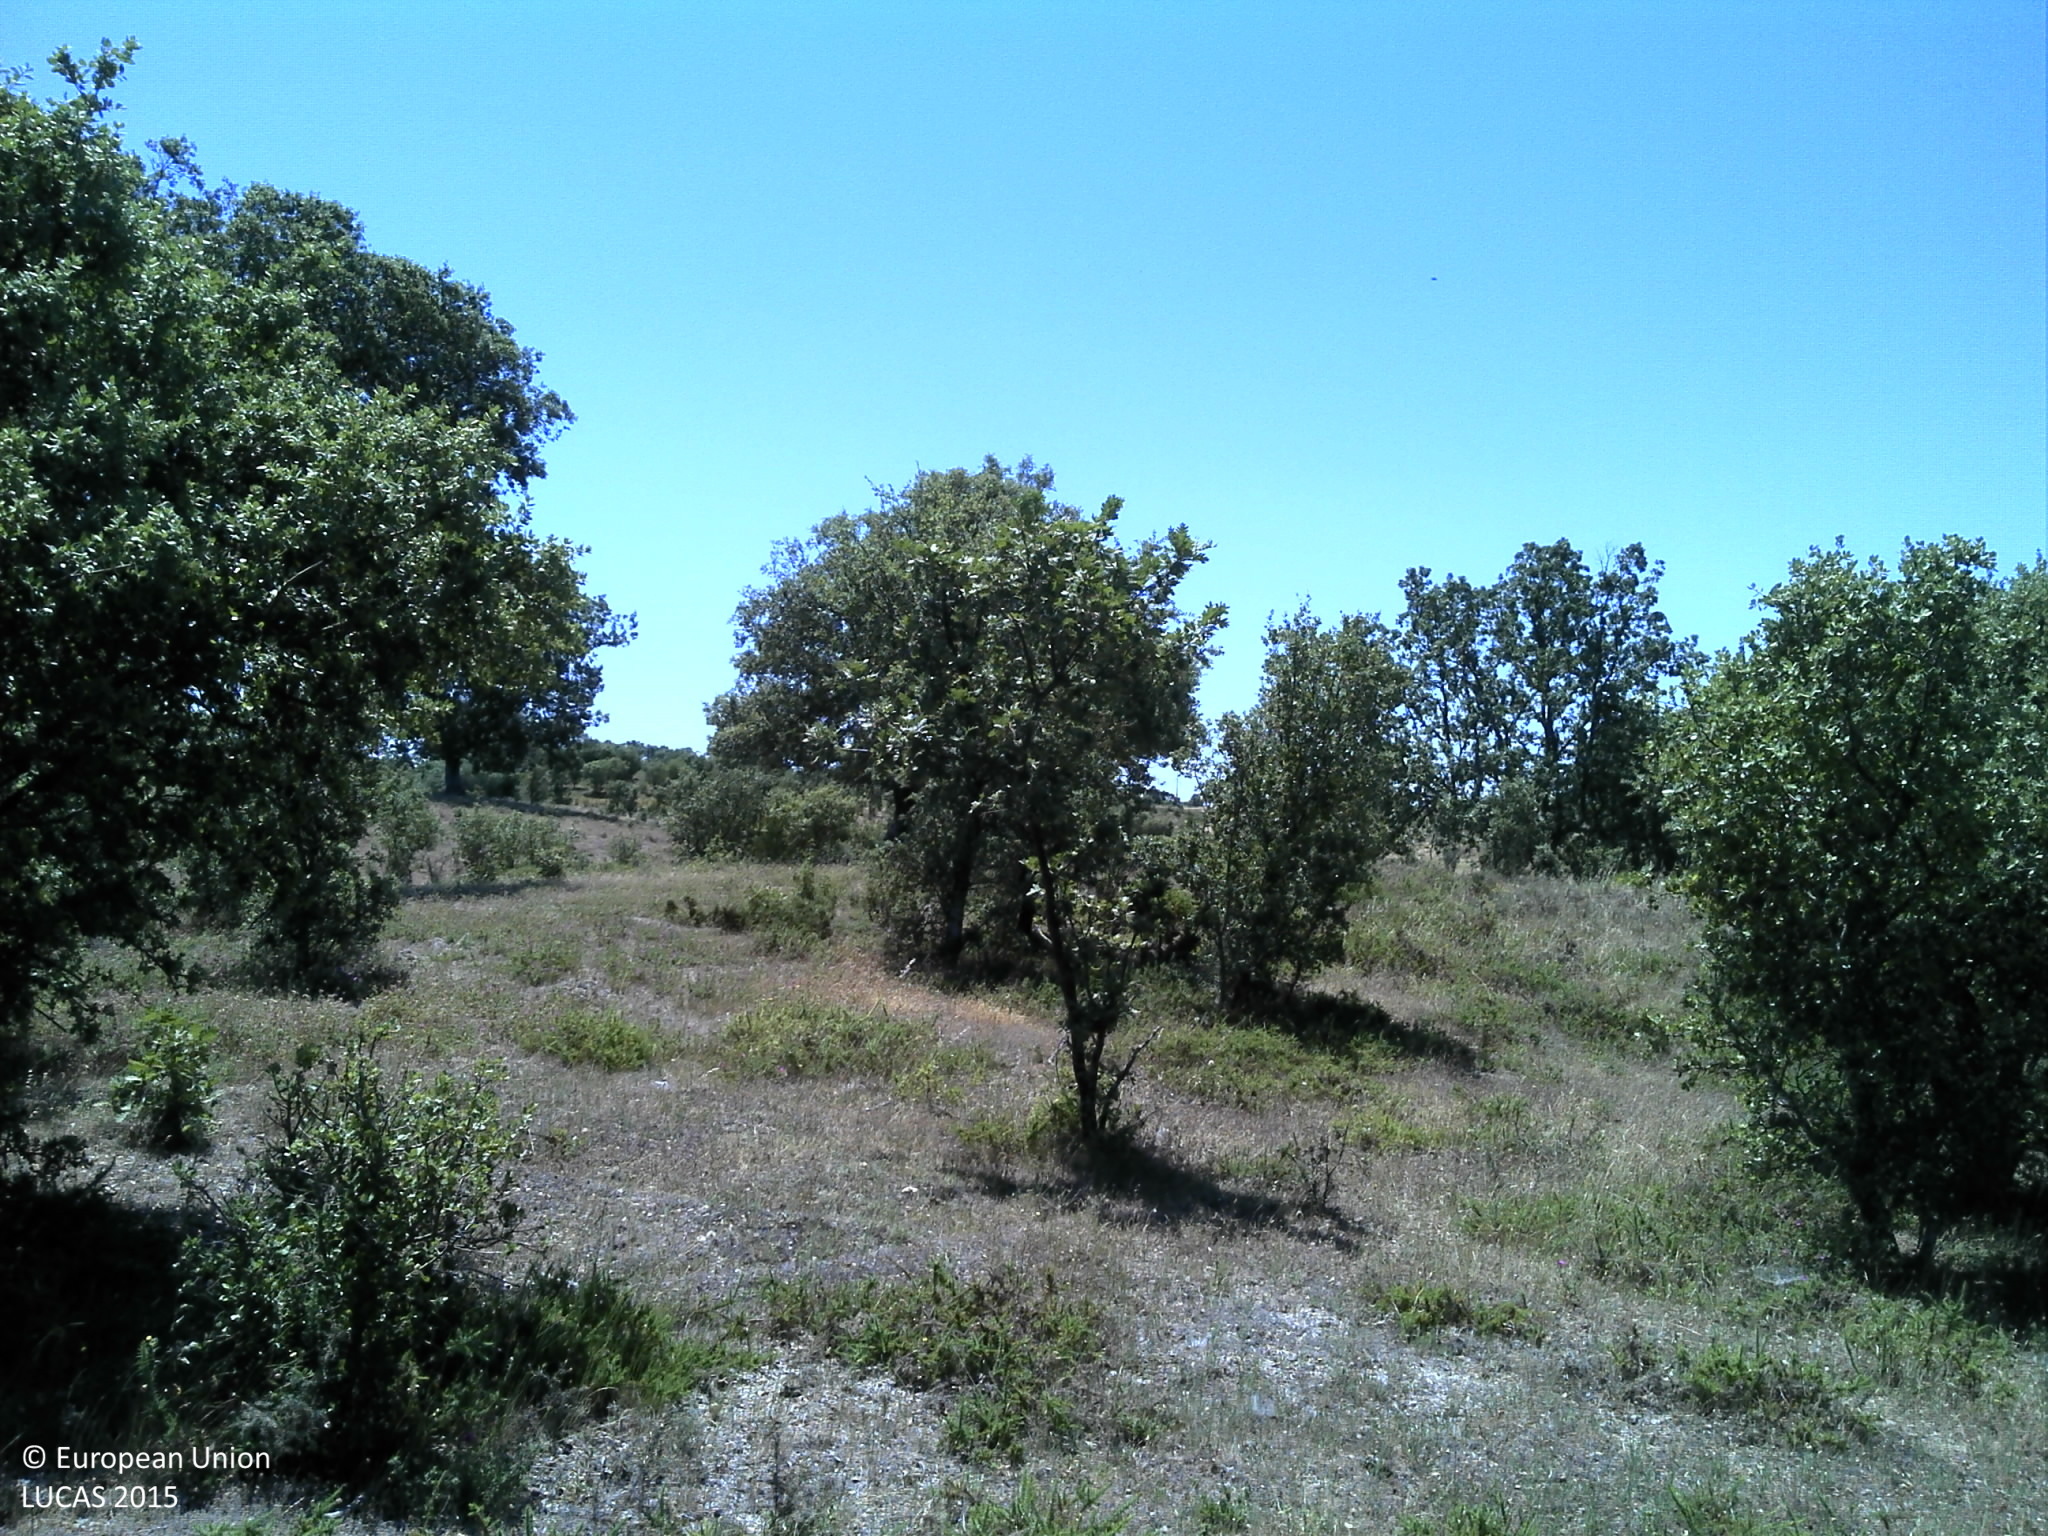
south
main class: Woodland
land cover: Broadleaved woodland
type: thermophilous deciduous forest
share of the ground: 25 - 50 %
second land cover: Grassland without tree/shrub cover
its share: 50 - 75 %
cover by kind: herbaceous plants 40 %, broadleaved forest trees 30 %, unconsolidated bare surface 25 %, shrubs 5 %
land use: Forestry
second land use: Agriculture (excluding fallow land and kitchen gardens)
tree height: > 5 m
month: May
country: PT
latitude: 39.4772
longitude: -7.6863
